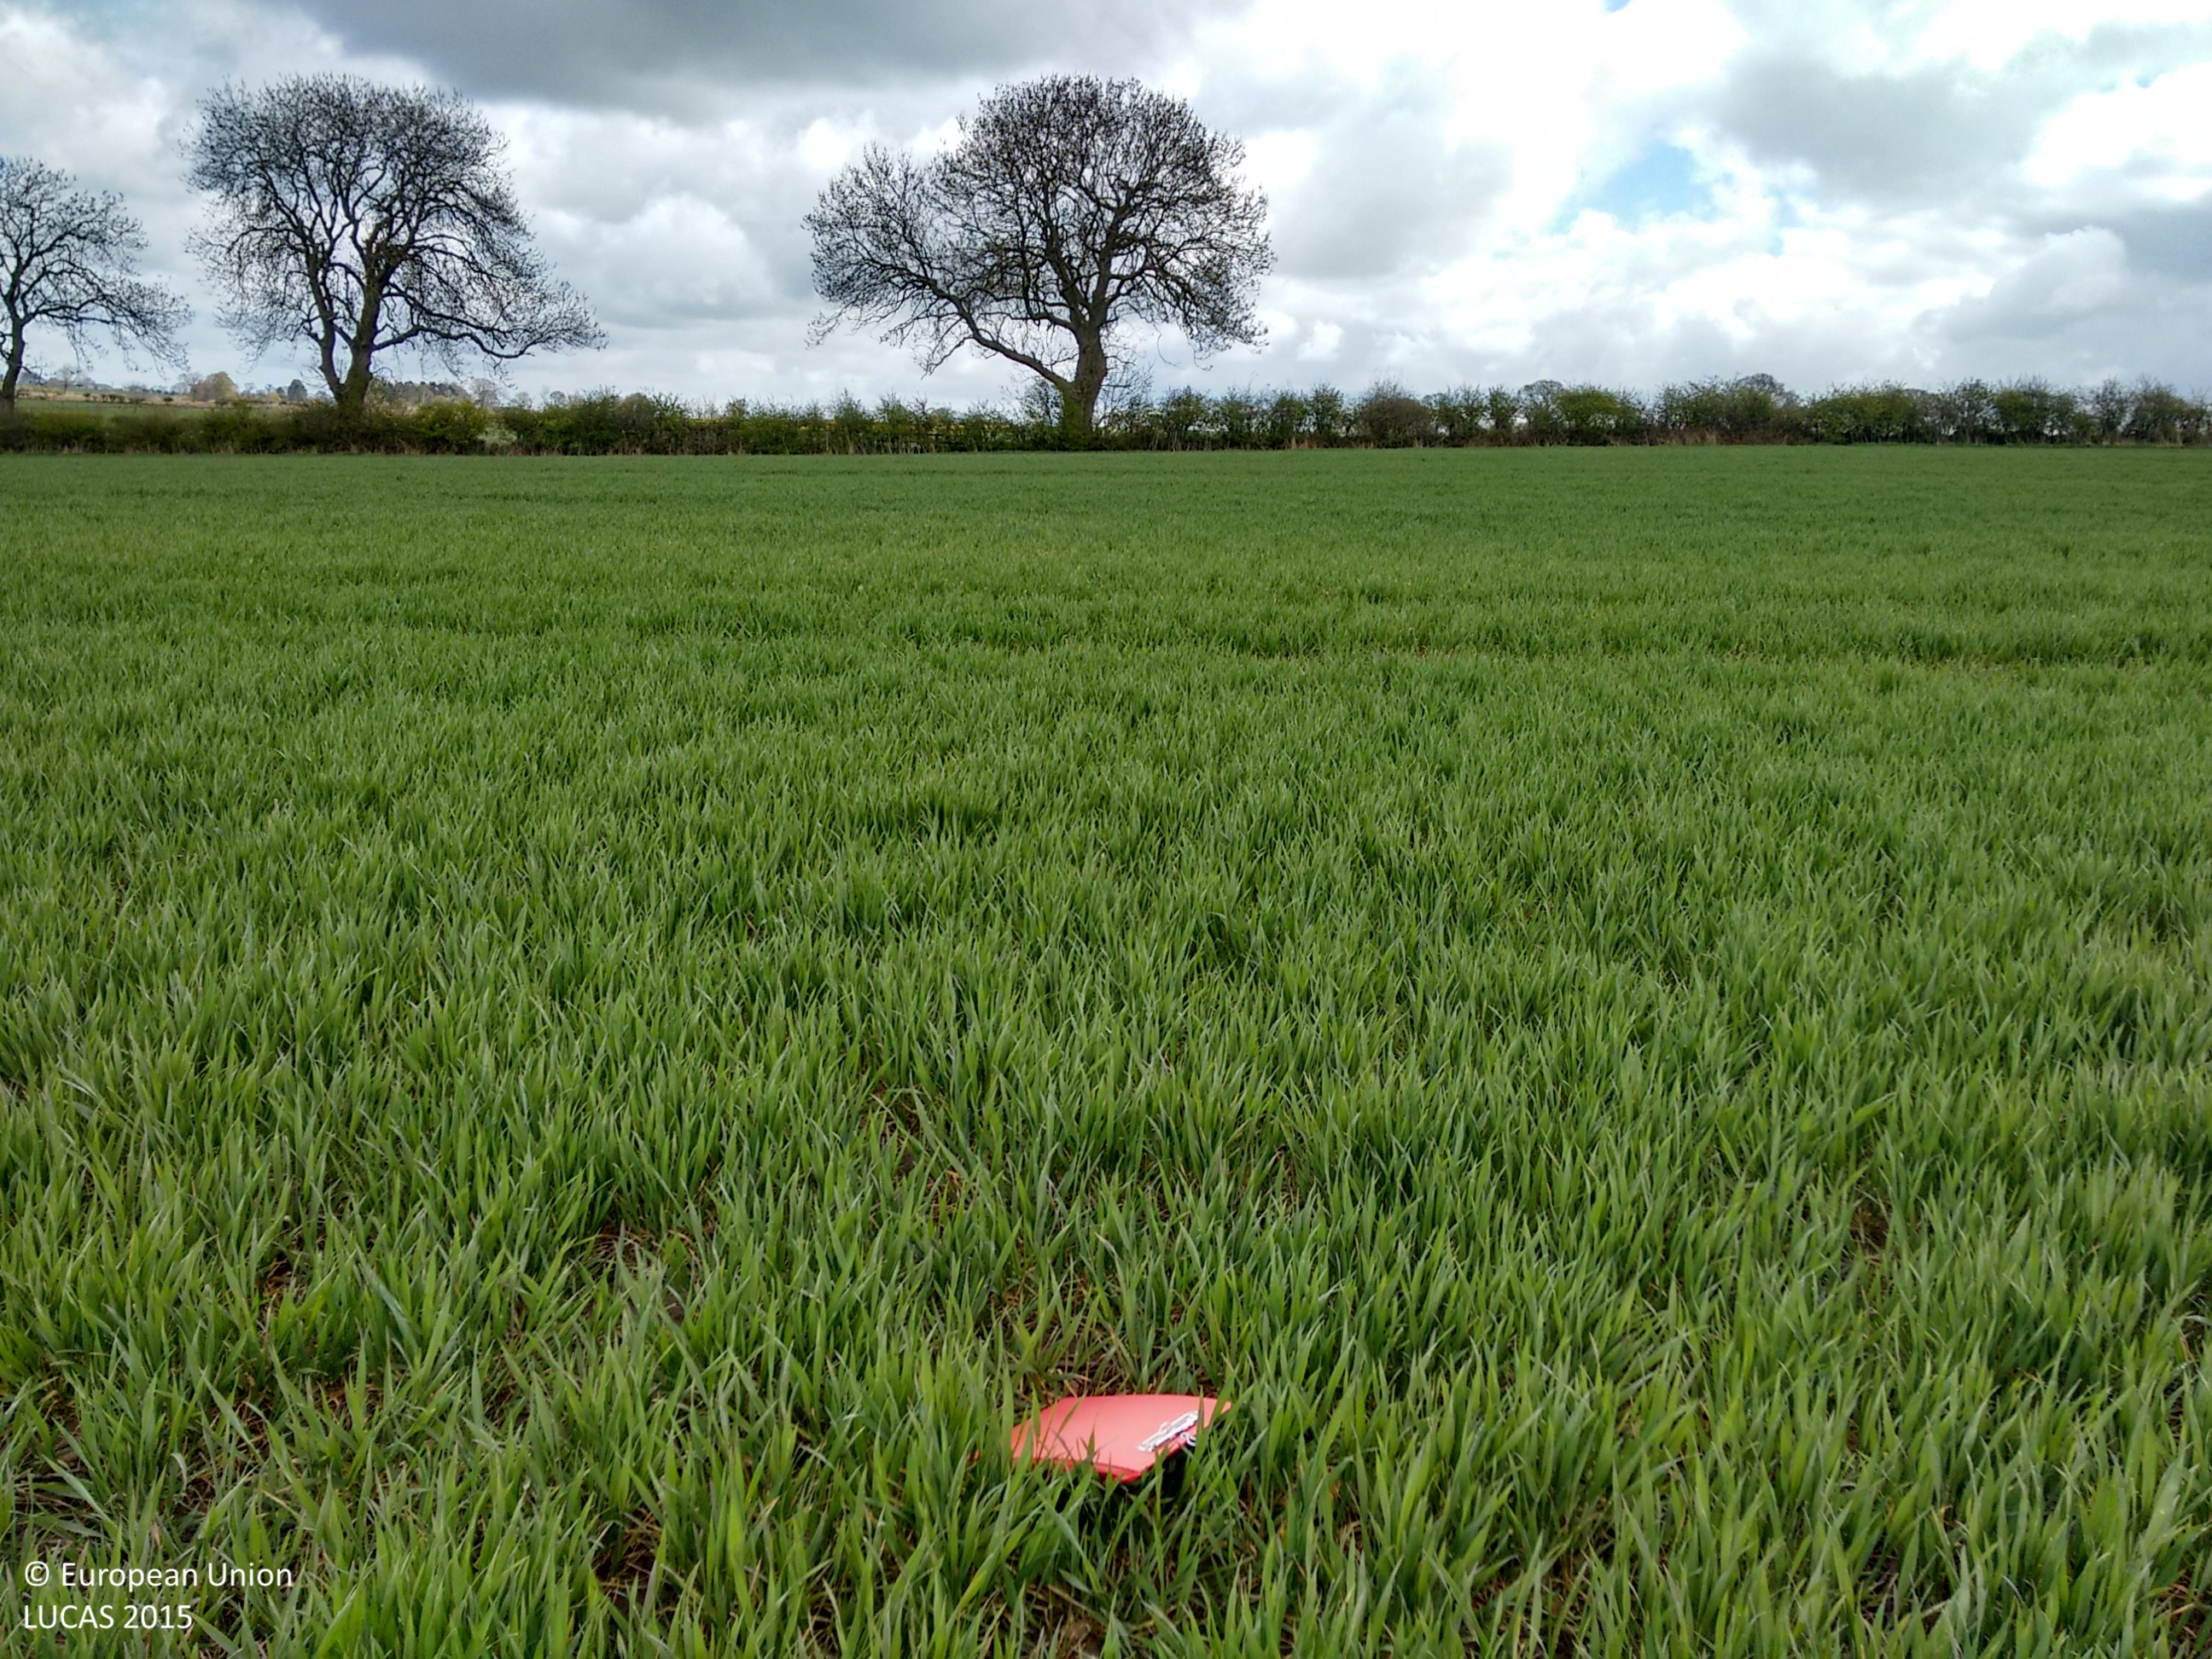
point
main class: Cropland
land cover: Common wheat
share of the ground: > 75 %
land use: Agriculture (excluding fallow land and kitchen gardens)
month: April
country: GB
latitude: 55.0316
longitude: -1.8964
